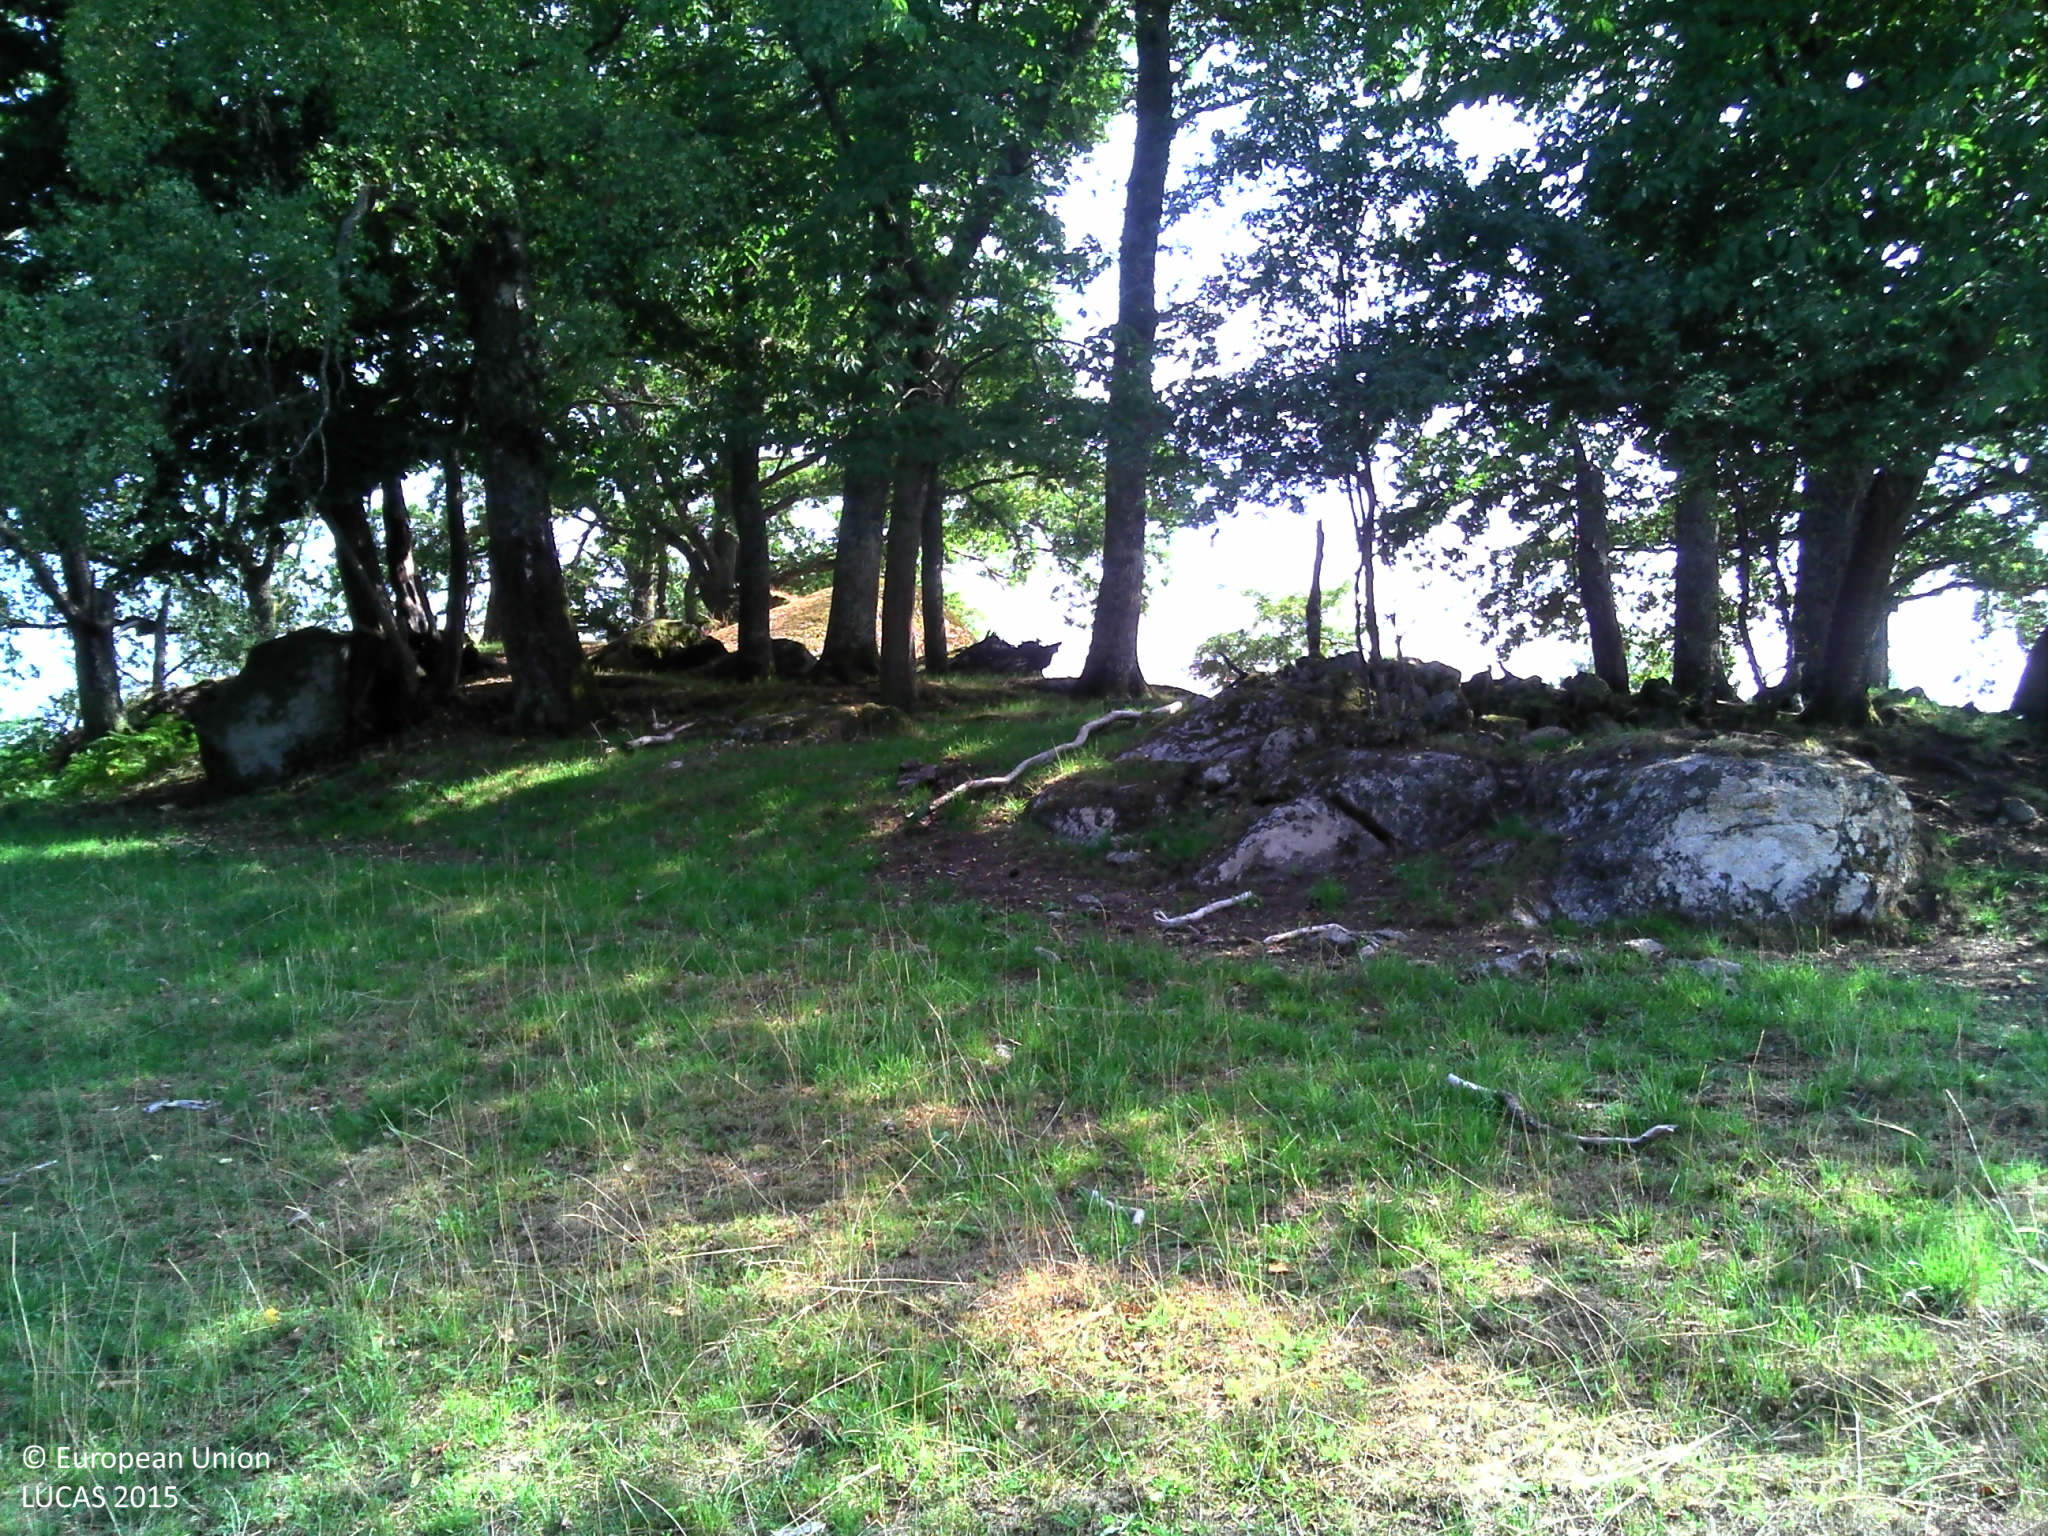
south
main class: Grassland
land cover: Grassland with sparse tree/shrub cover
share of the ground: > 75 %
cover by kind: herbaceous plants 90 %, broadleaved forest trees 5 %, shrubs 5 %
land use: Agriculture (excluding fallow land and kitchen gardens)
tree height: > 5 m
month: August
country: FR
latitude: 46.2686
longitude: 2.2484
